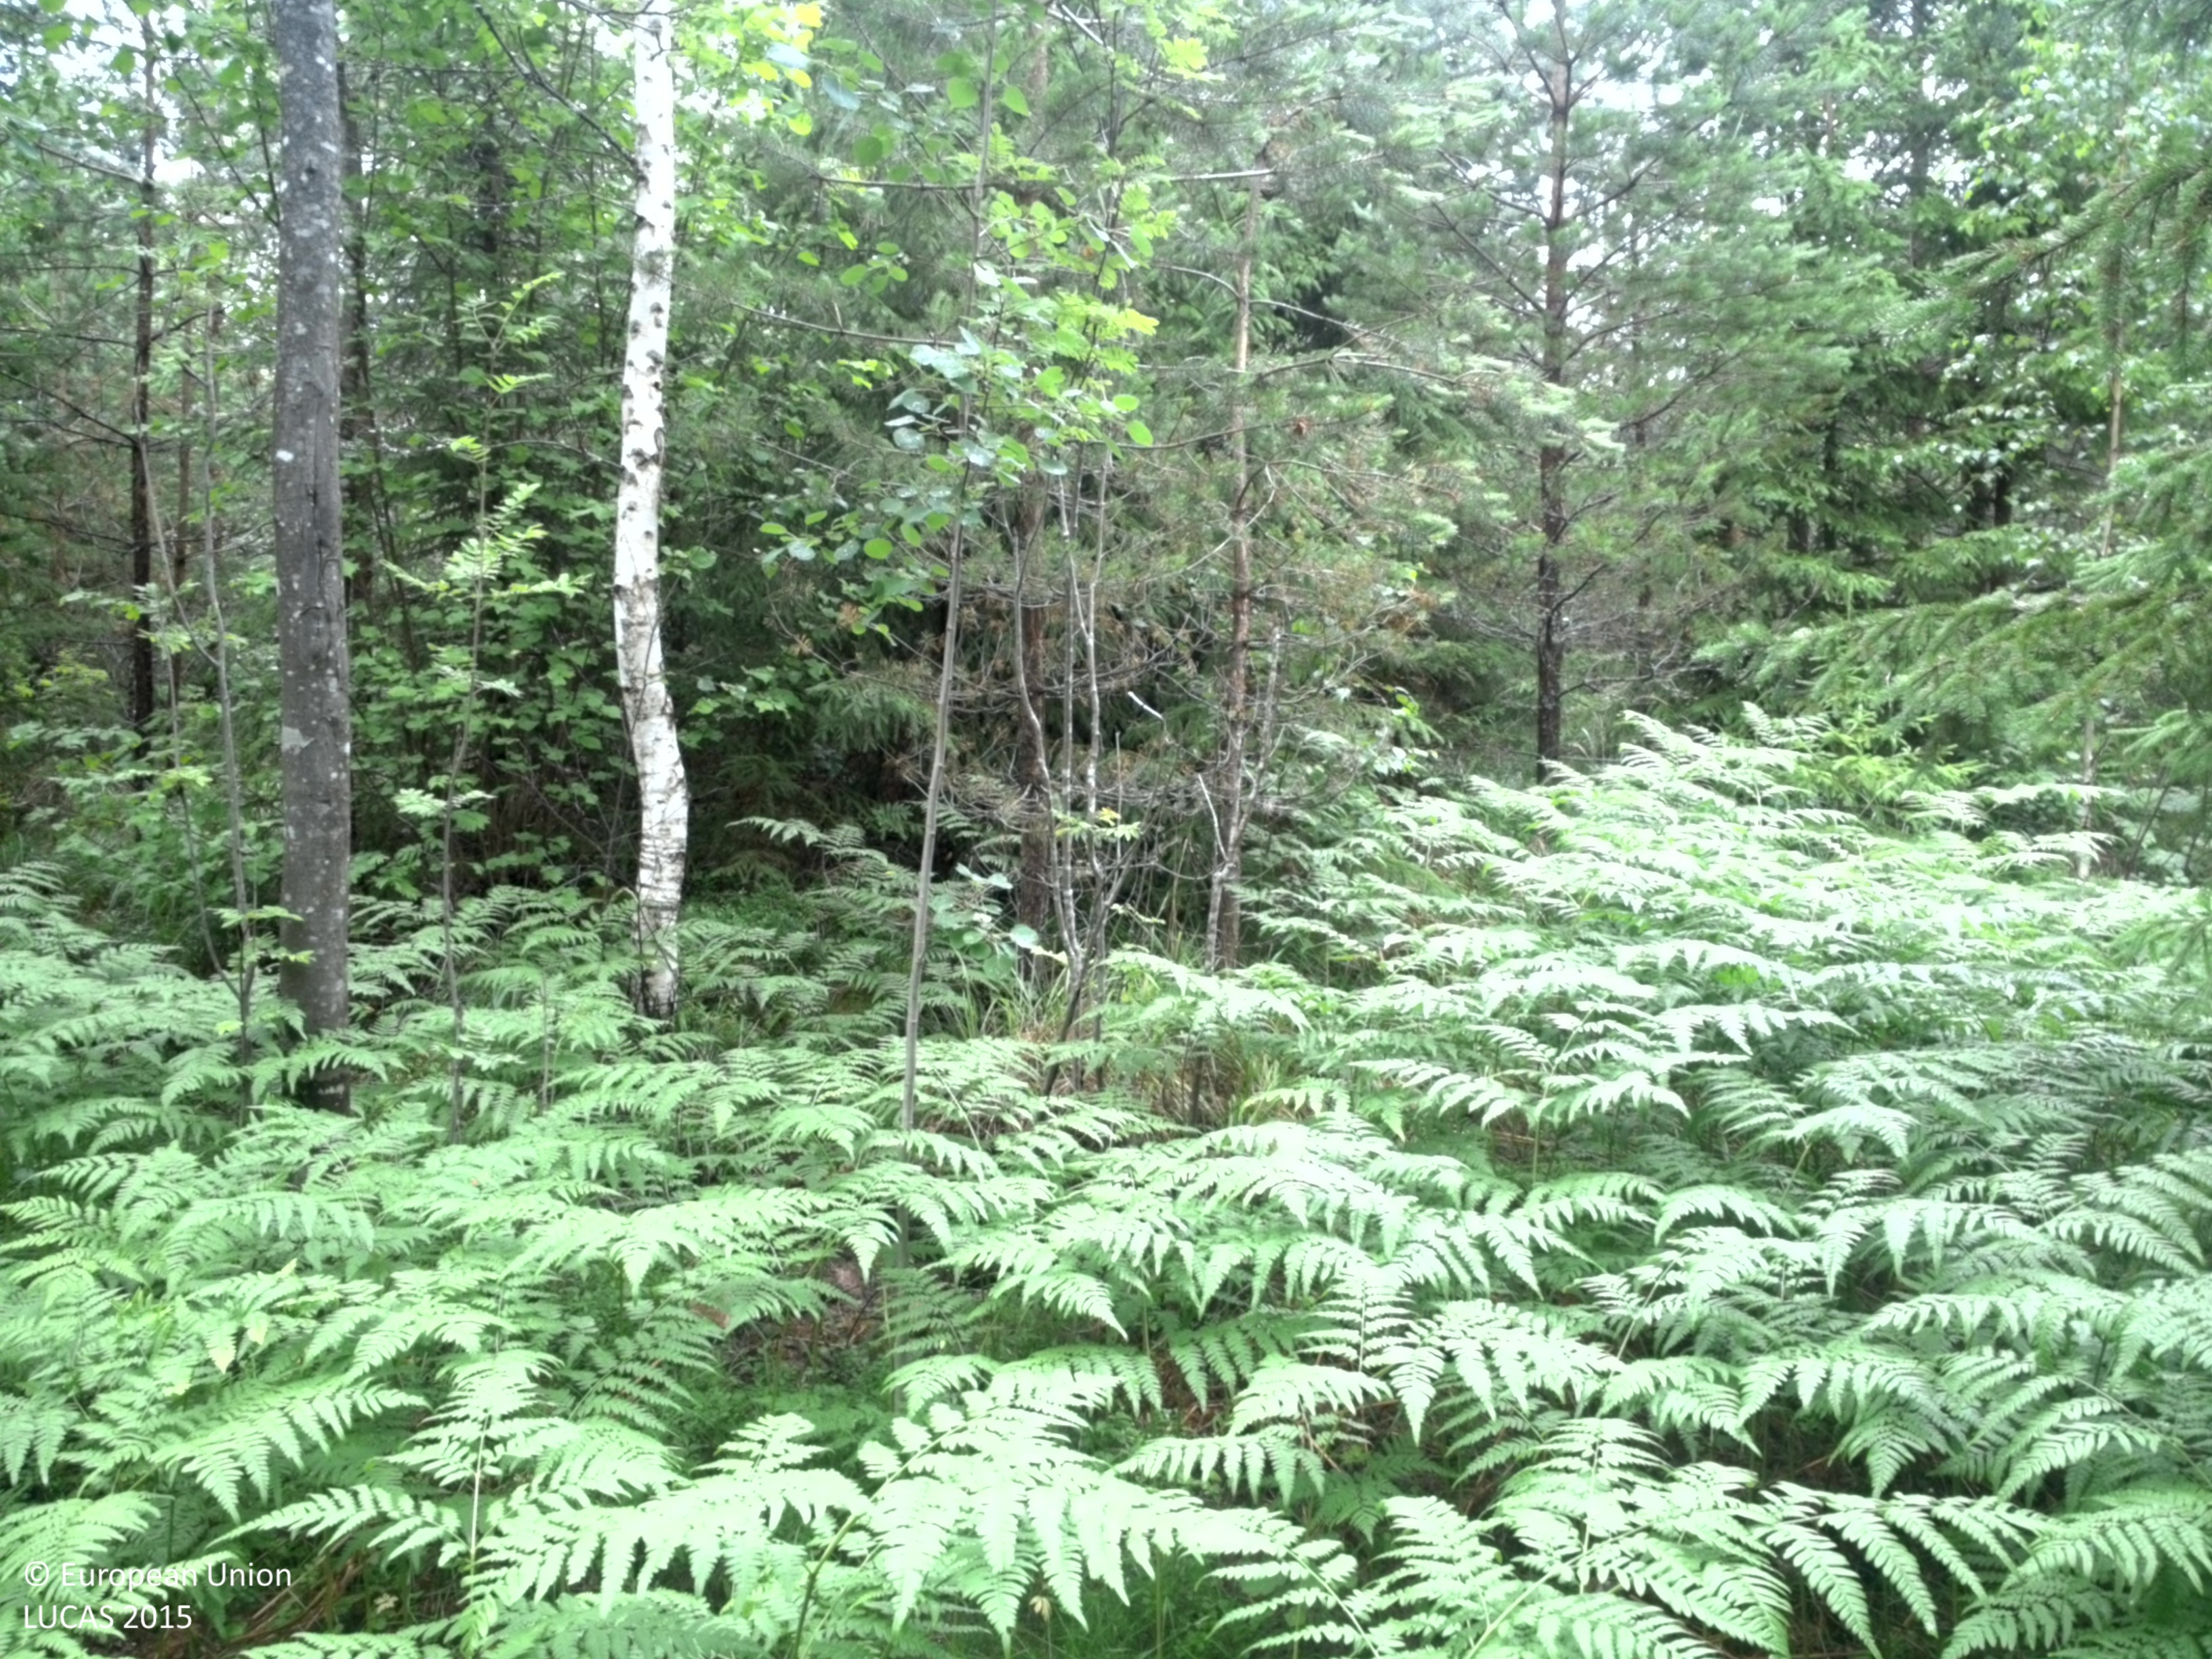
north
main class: Woodland
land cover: Other coniferous woodland
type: boreal forest
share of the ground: > 75 %
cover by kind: coniferous forest trees 60 %, broadleaved forest trees 20 %, herbaceous plants 20 %
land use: Forestry
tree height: > 5 m
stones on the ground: < 10 %
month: July
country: SE
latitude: 60.1587
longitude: 17.2162
